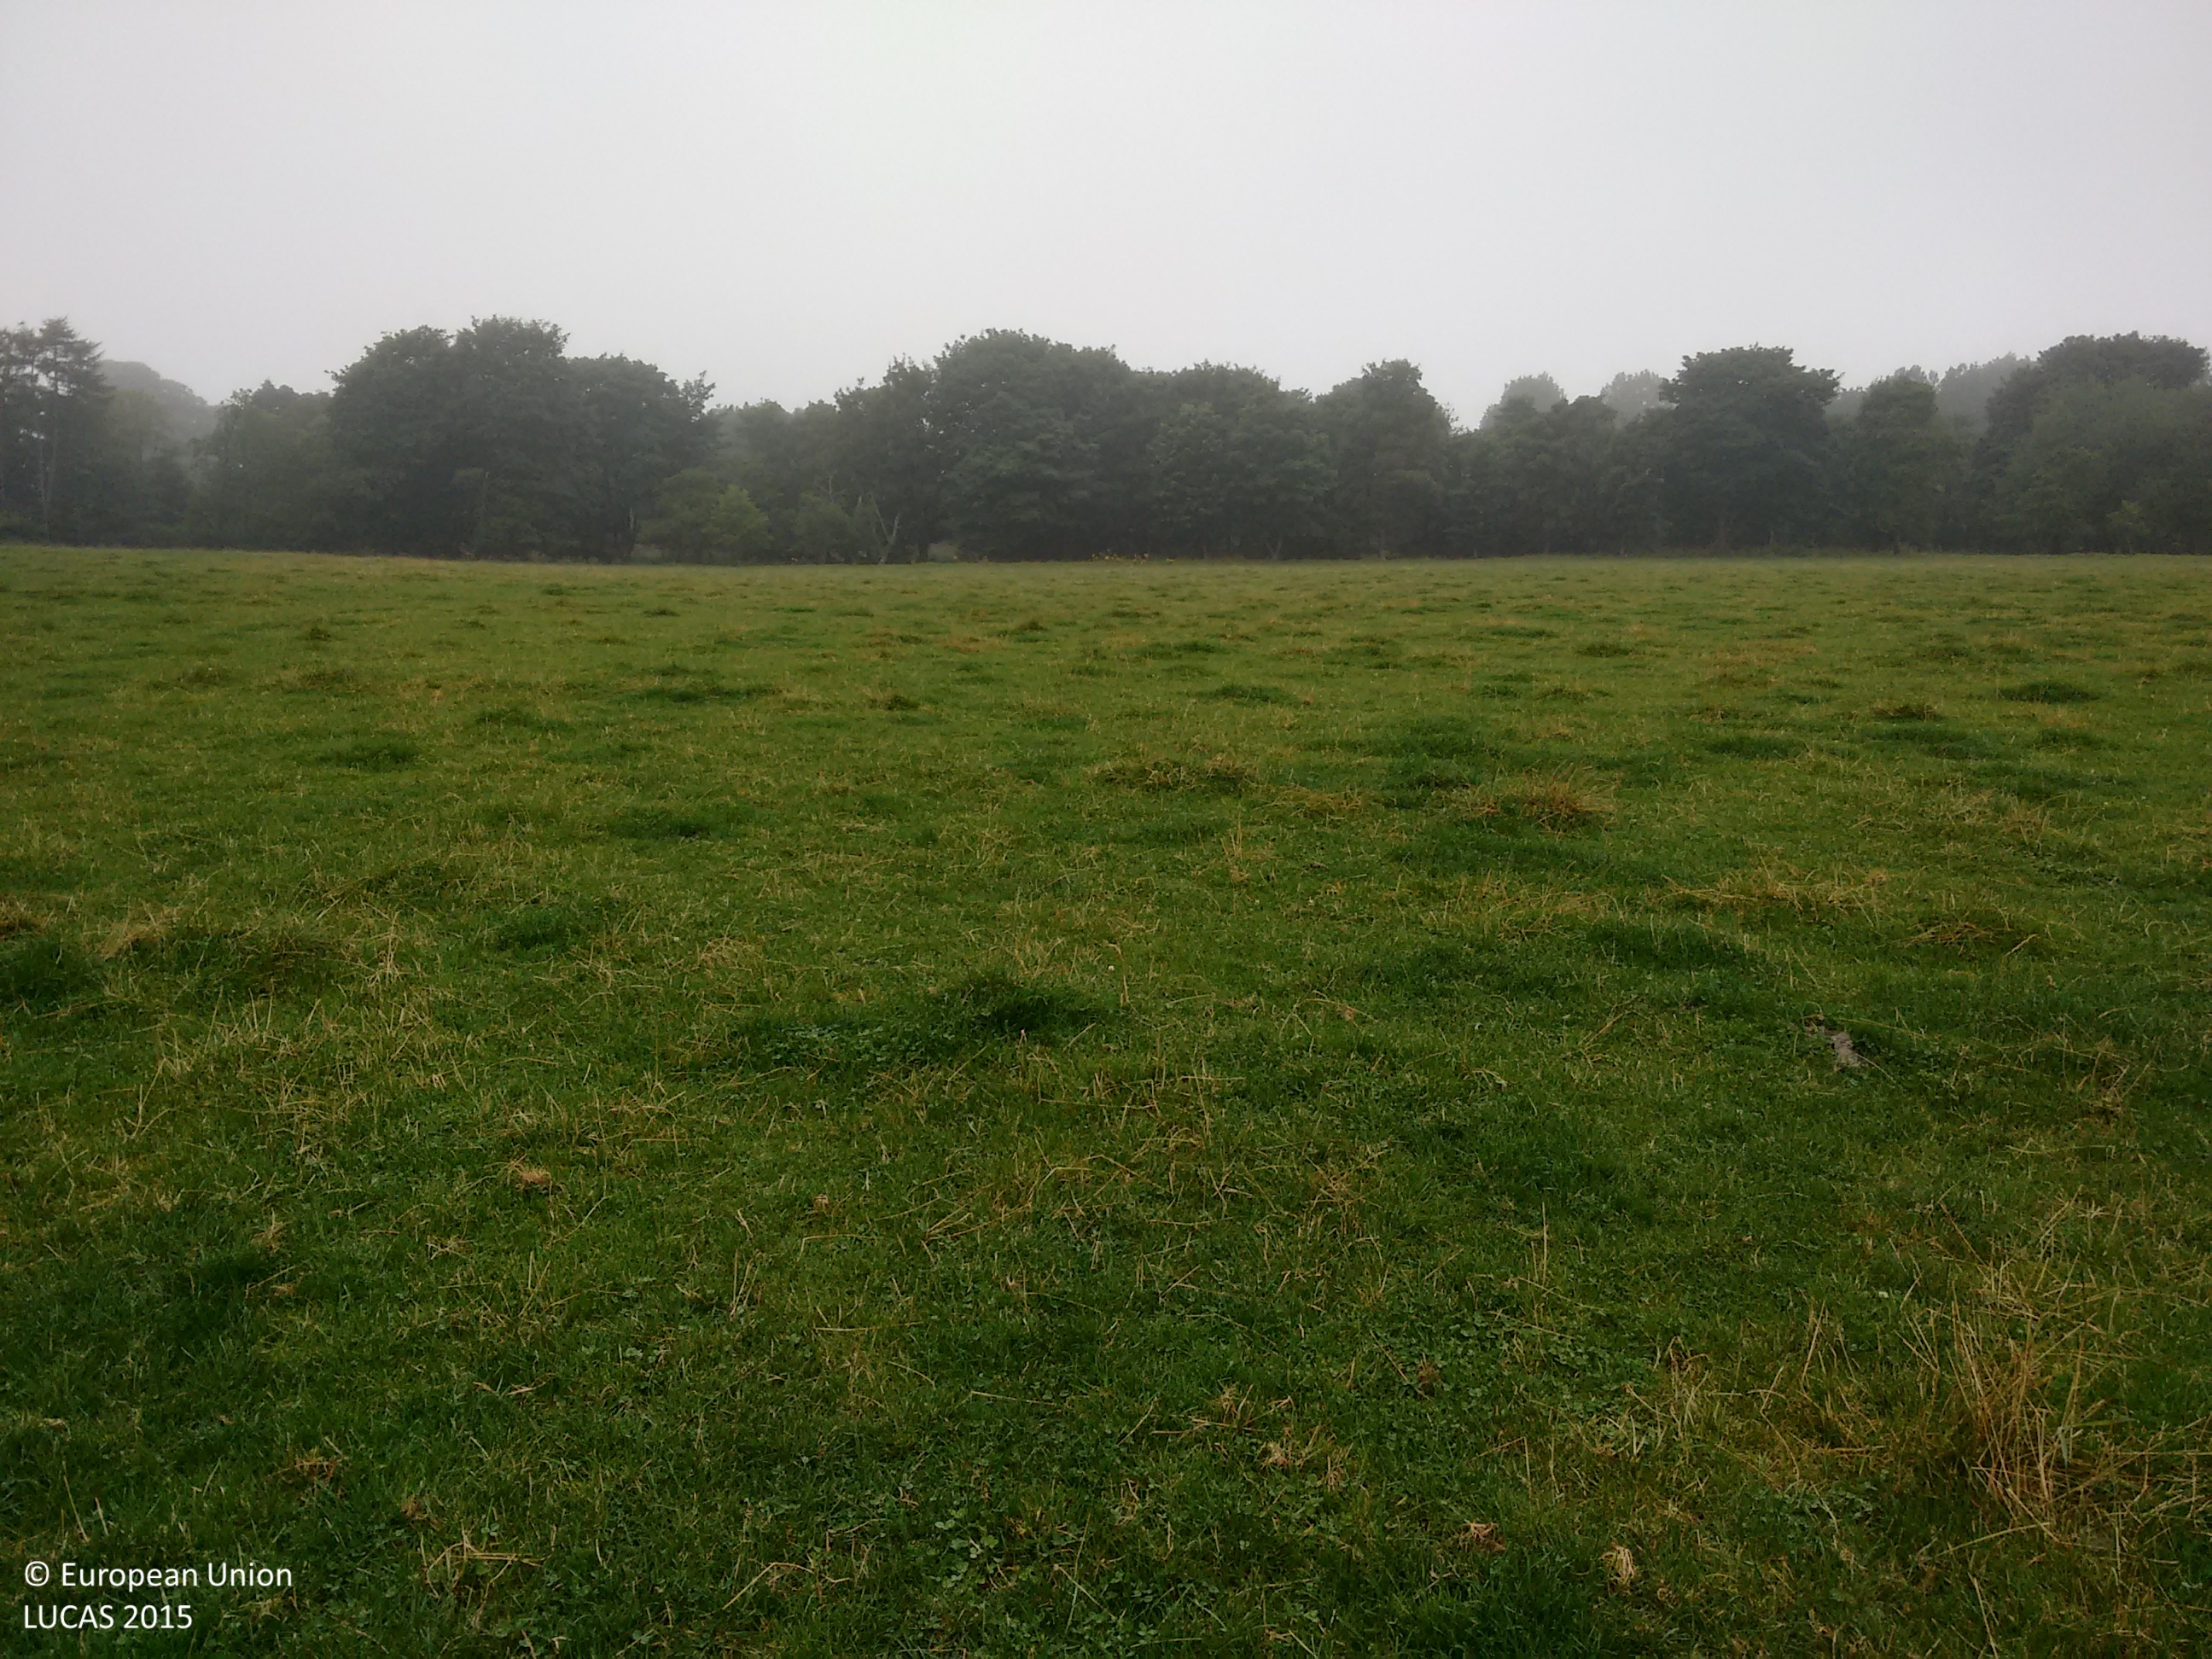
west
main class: Grassland
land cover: Grassland without tree/shrub cover
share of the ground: > 75 %
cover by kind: herbaceous plants 100 %
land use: Agriculture (excluding fallow land and kitchen gardens)
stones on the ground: < 10 %
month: September
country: GB
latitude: 57.5686
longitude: -3.8701
